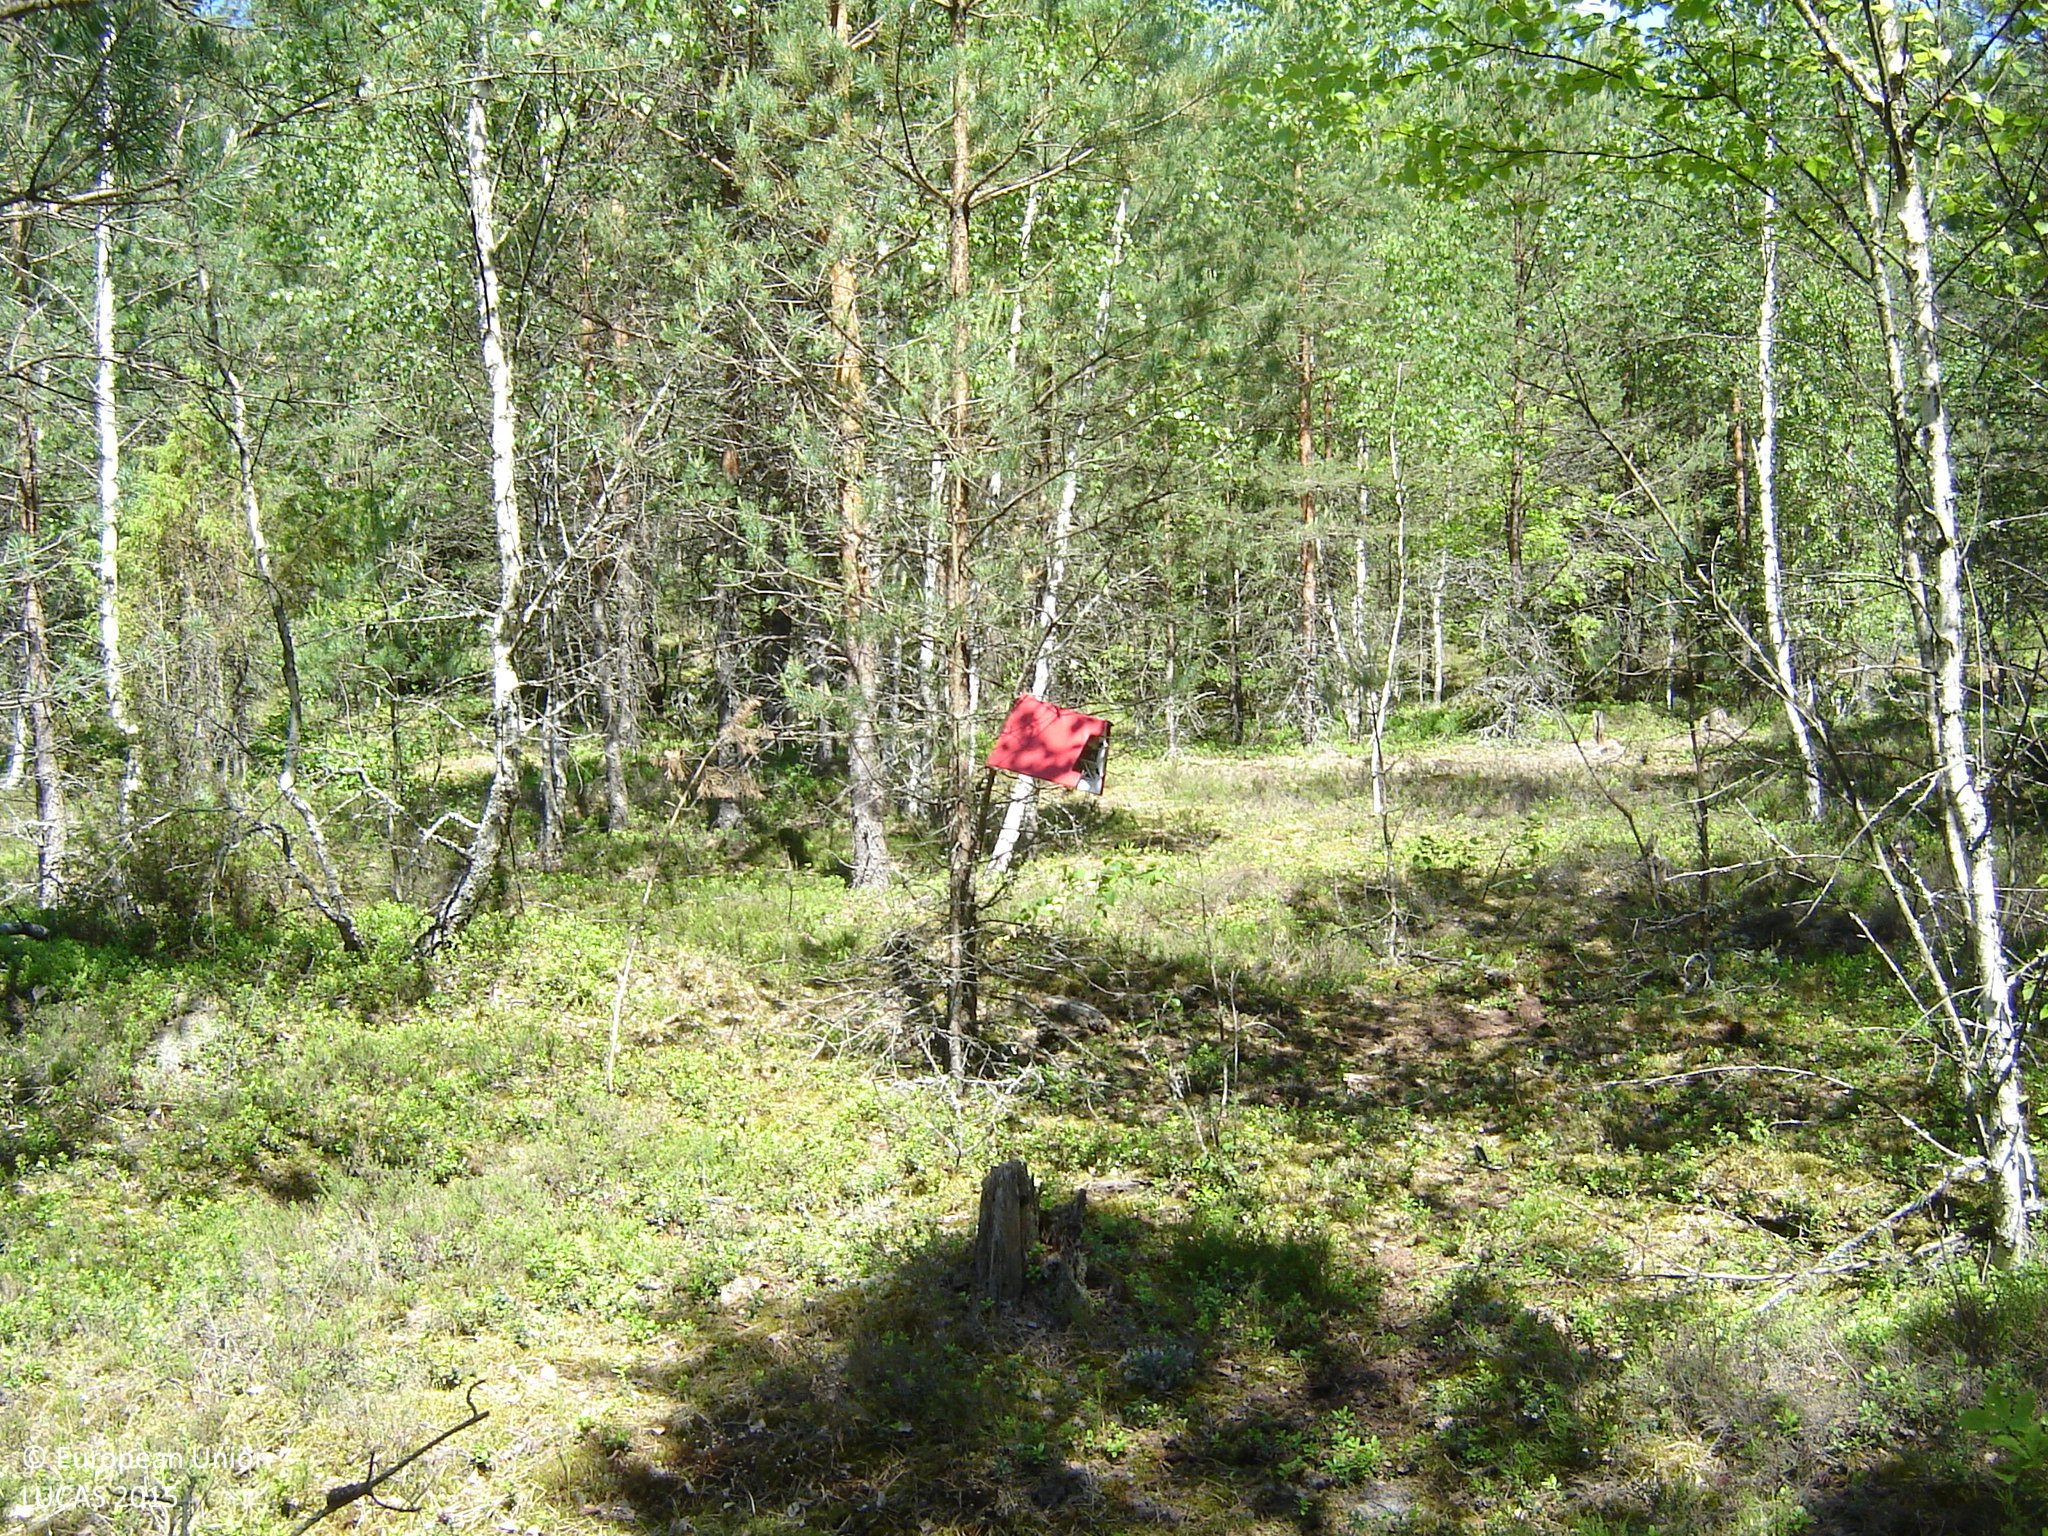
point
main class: Woodland
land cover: Pine dominated coniferous woodland
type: hemiboreal forest and nemoral coniferous forest and mixed broadleaved-coniferous forest
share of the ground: > 75 %
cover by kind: coniferous forest trees 75 %, shrubs 10 %, lichens and mosses 10 %, broadleaved forest trees 5 %
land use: Forestry
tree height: > 5 m
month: June
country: LT
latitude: 55.6357
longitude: 25.0936
